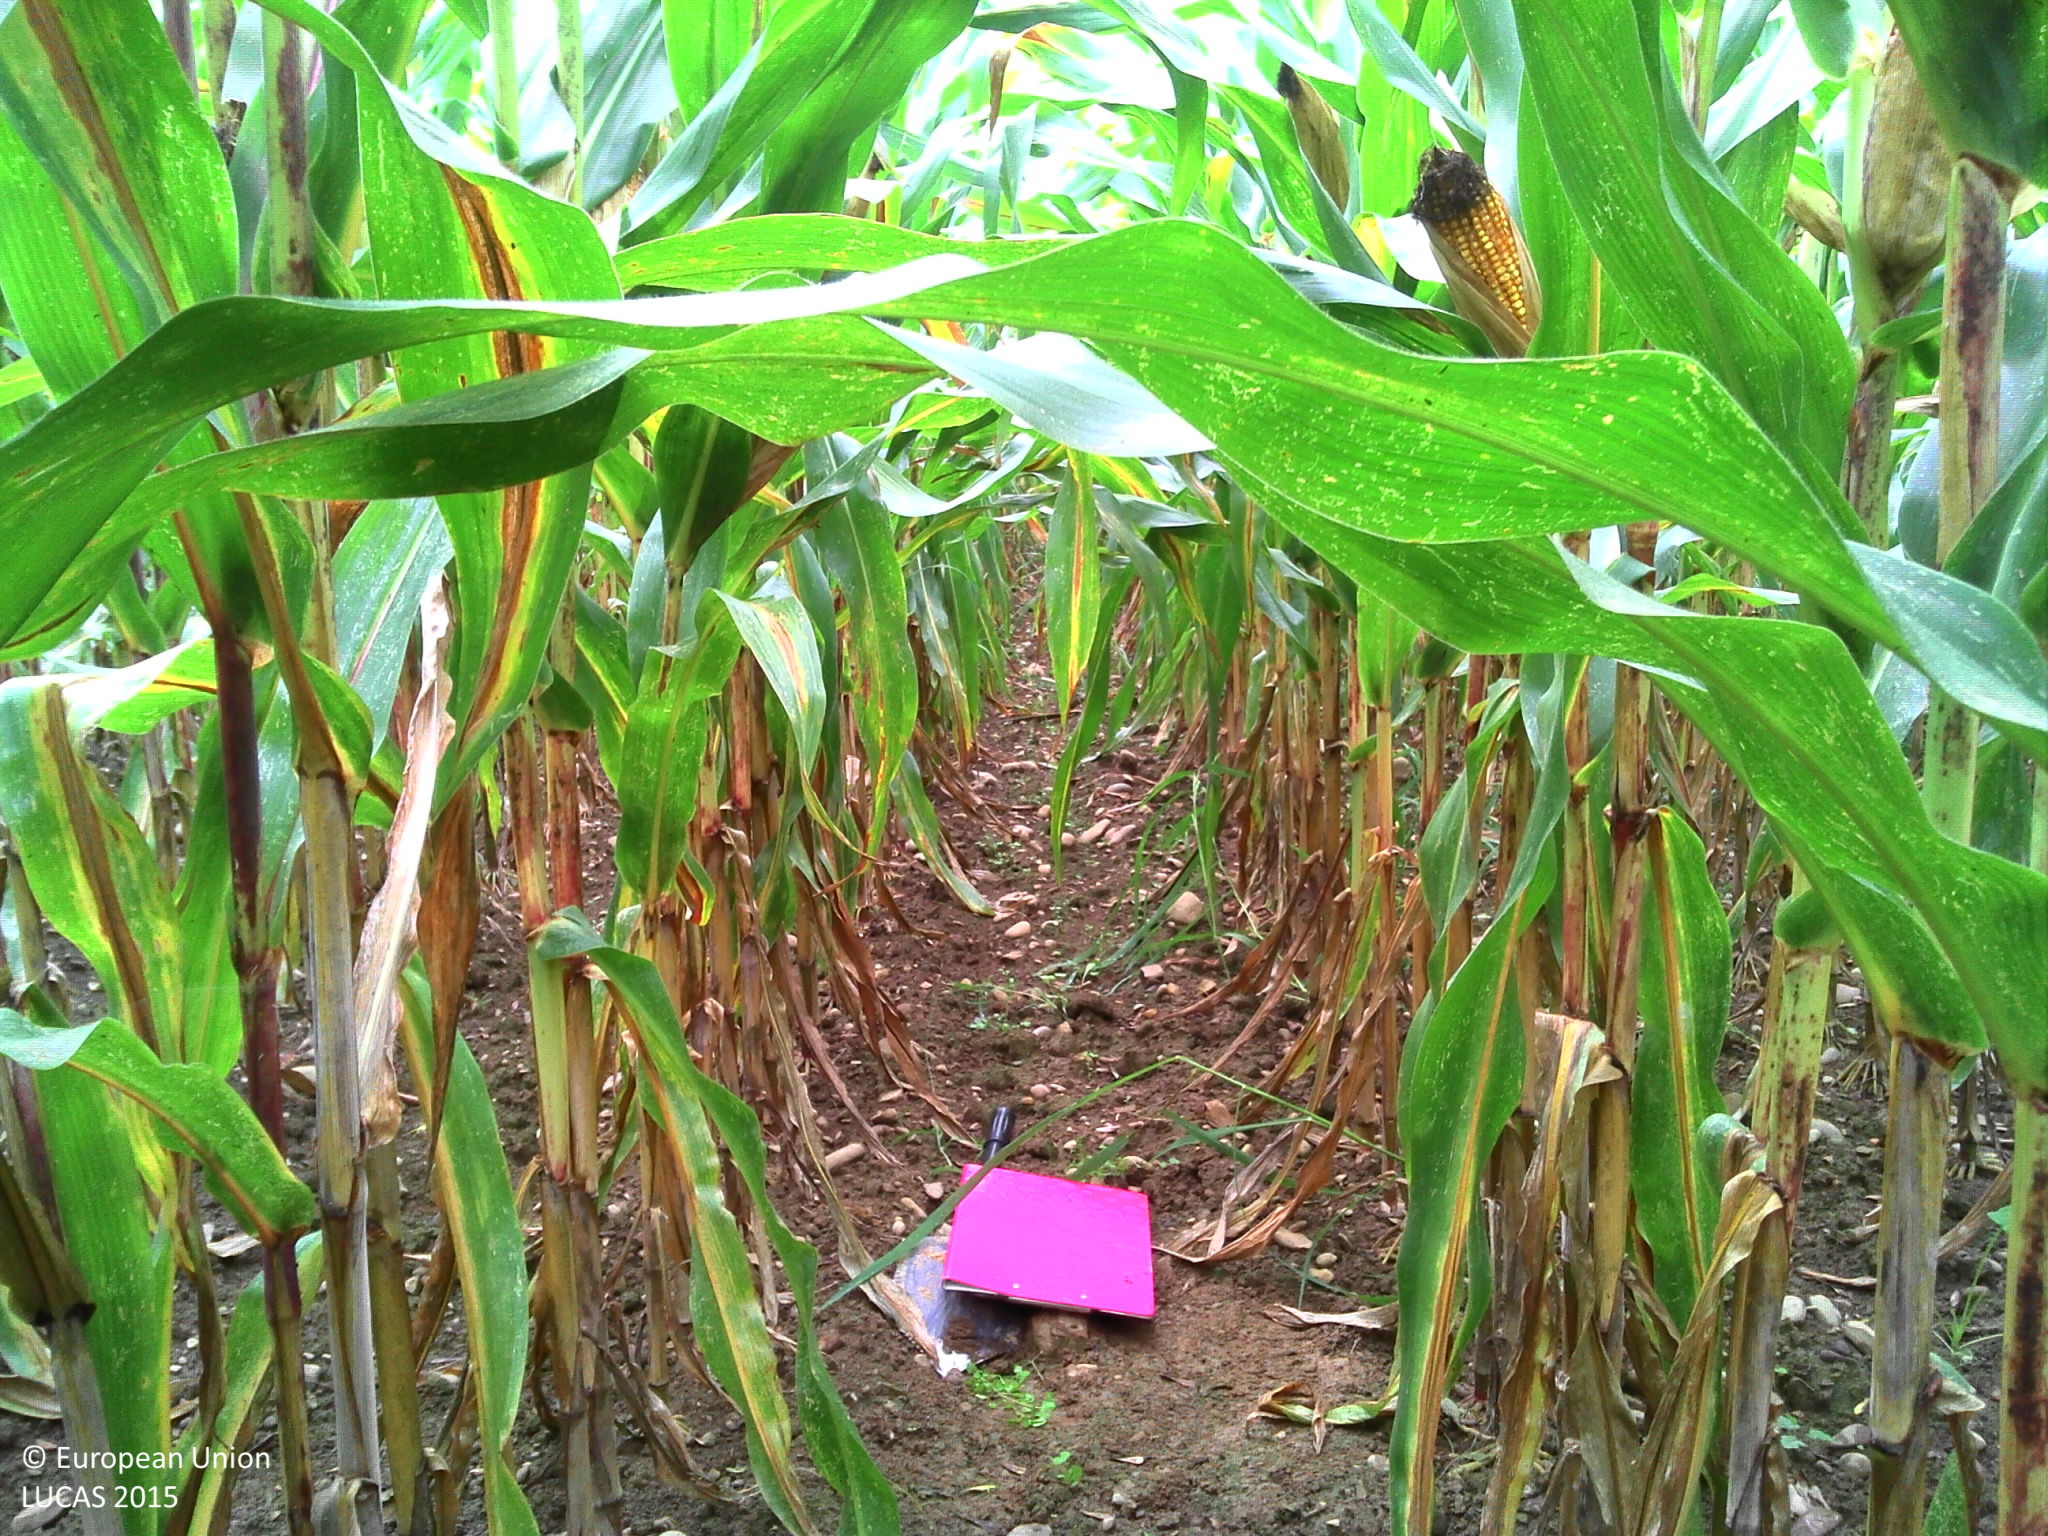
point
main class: Cropland
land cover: Maize
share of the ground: > 75 %
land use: Agriculture (excluding fallow land and kitchen gardens)
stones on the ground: 10 - 25 %
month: September
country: FR
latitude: 43.2885
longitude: -0.1481
